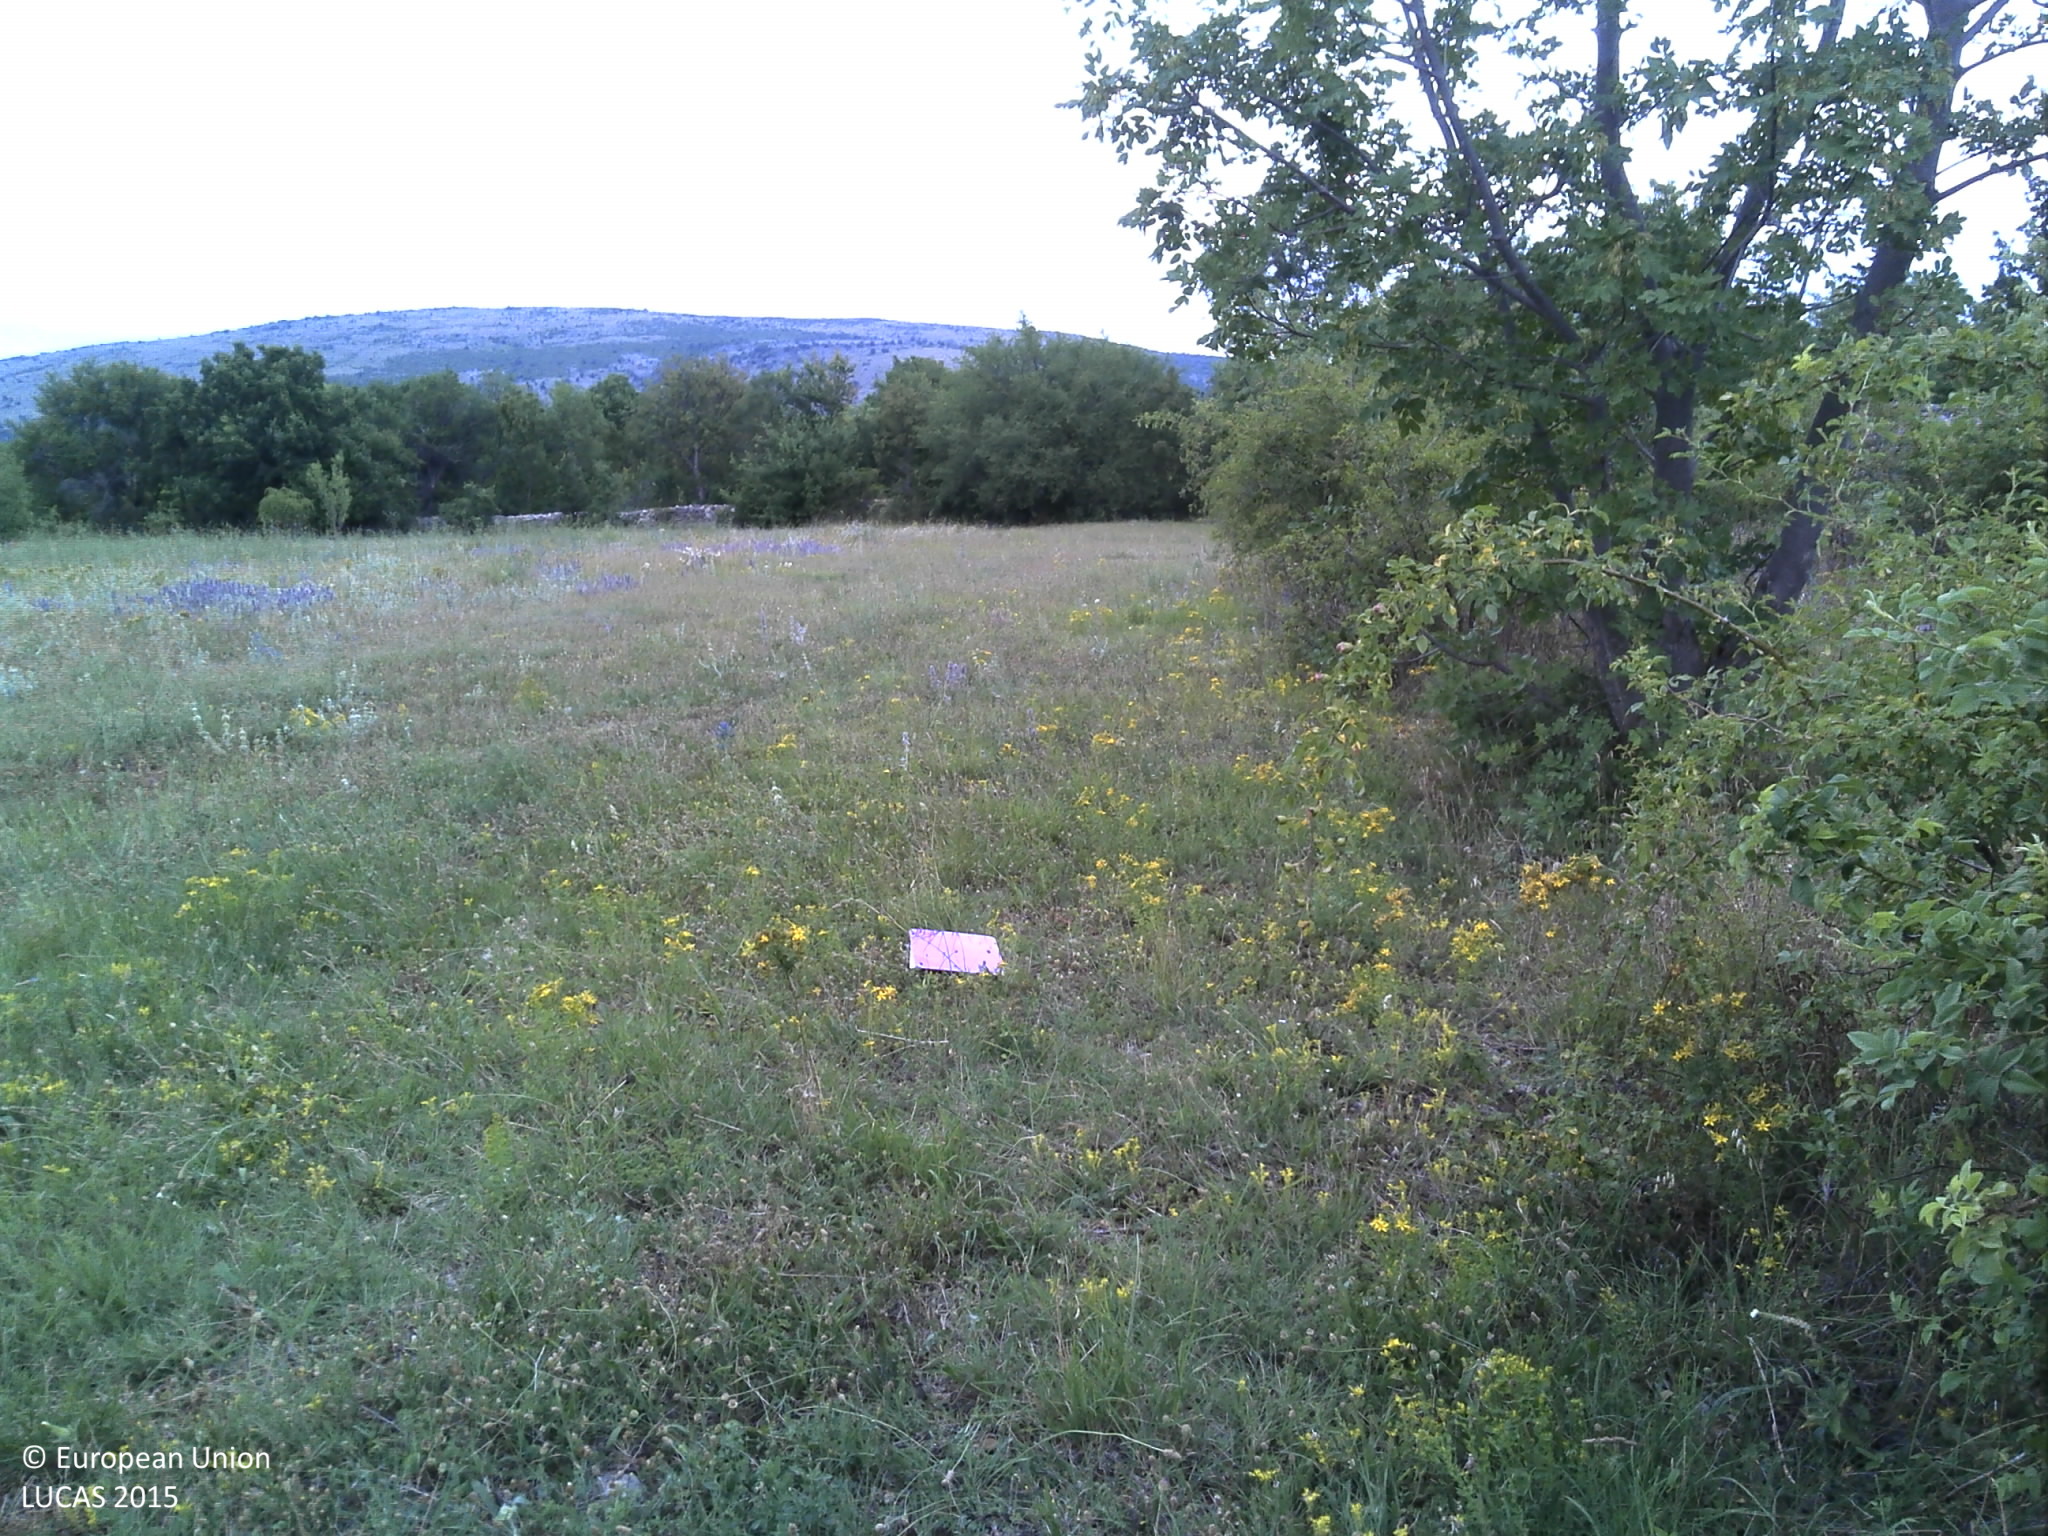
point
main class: Shrubland
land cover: Shrubland with sparse tree cover
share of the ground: 50 - 75 %
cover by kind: shrubs 50 %, herbaceous plants 45 %, broadleaved forest trees 5 %
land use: Fallow land
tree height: < 5 m
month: June
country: HR
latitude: 44.0613
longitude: 16.1220
